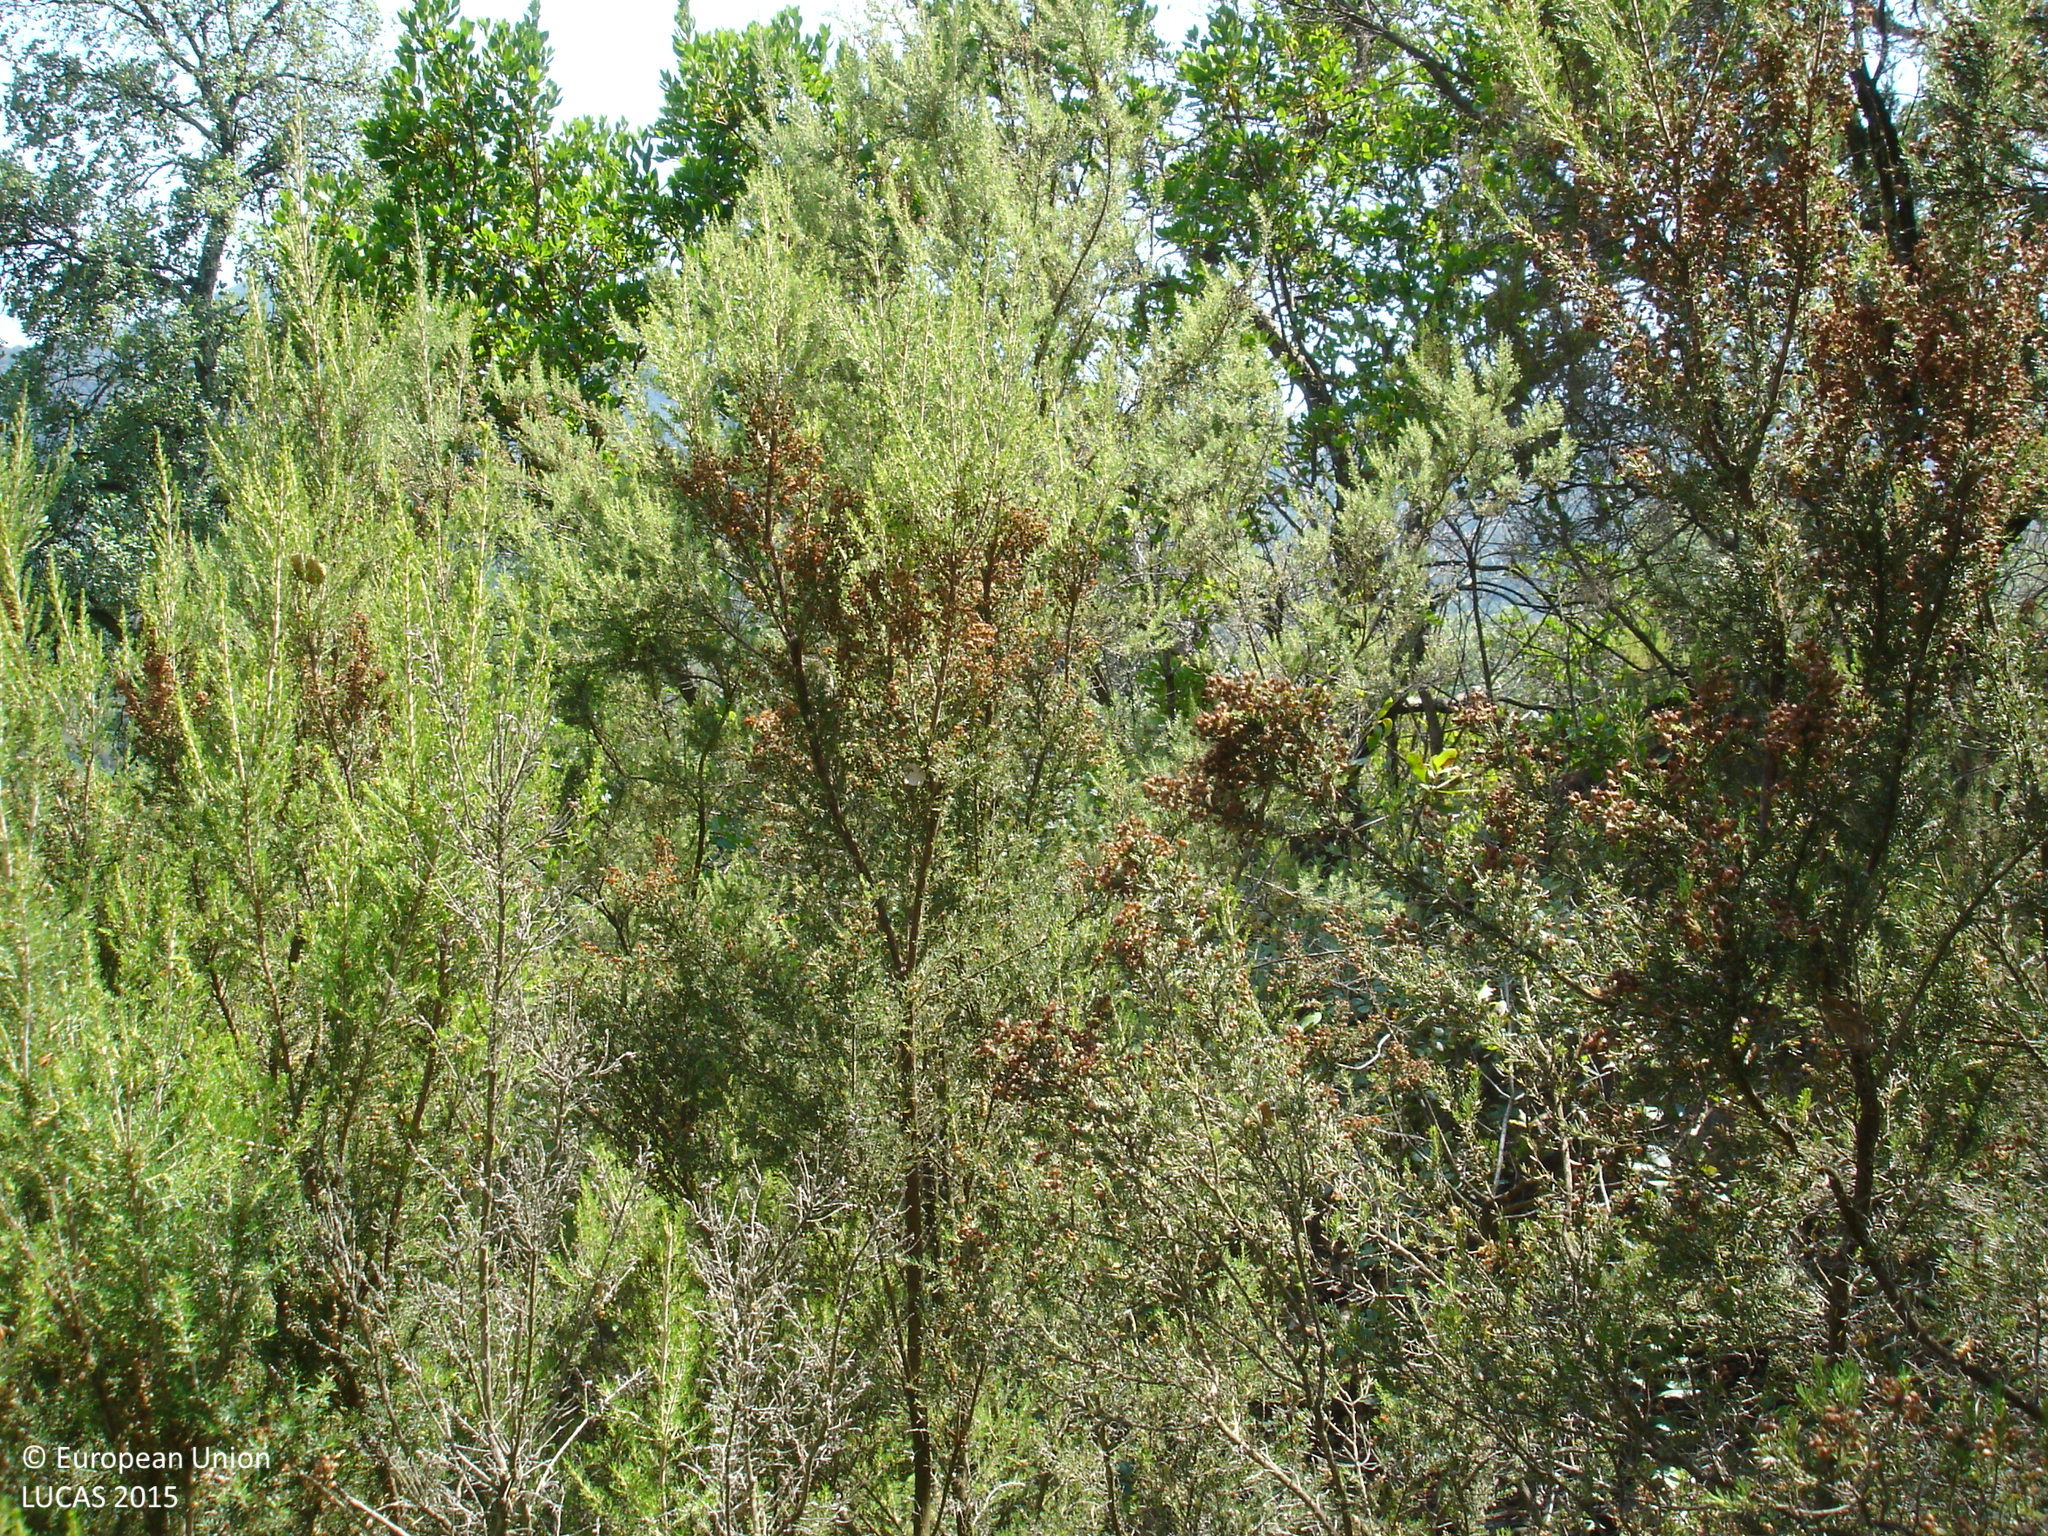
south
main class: Woodland
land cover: Other mixed woodland
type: thermophilous deciduous forest
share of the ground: > 75 %
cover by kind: coniferous forest trees 40 %, broadleaved forest trees 40 %, shrubs 15 %, herbaceous plants 5 %
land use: Forestry
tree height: > 5 m
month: June
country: ES
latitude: 41.7122
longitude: 2.6012
